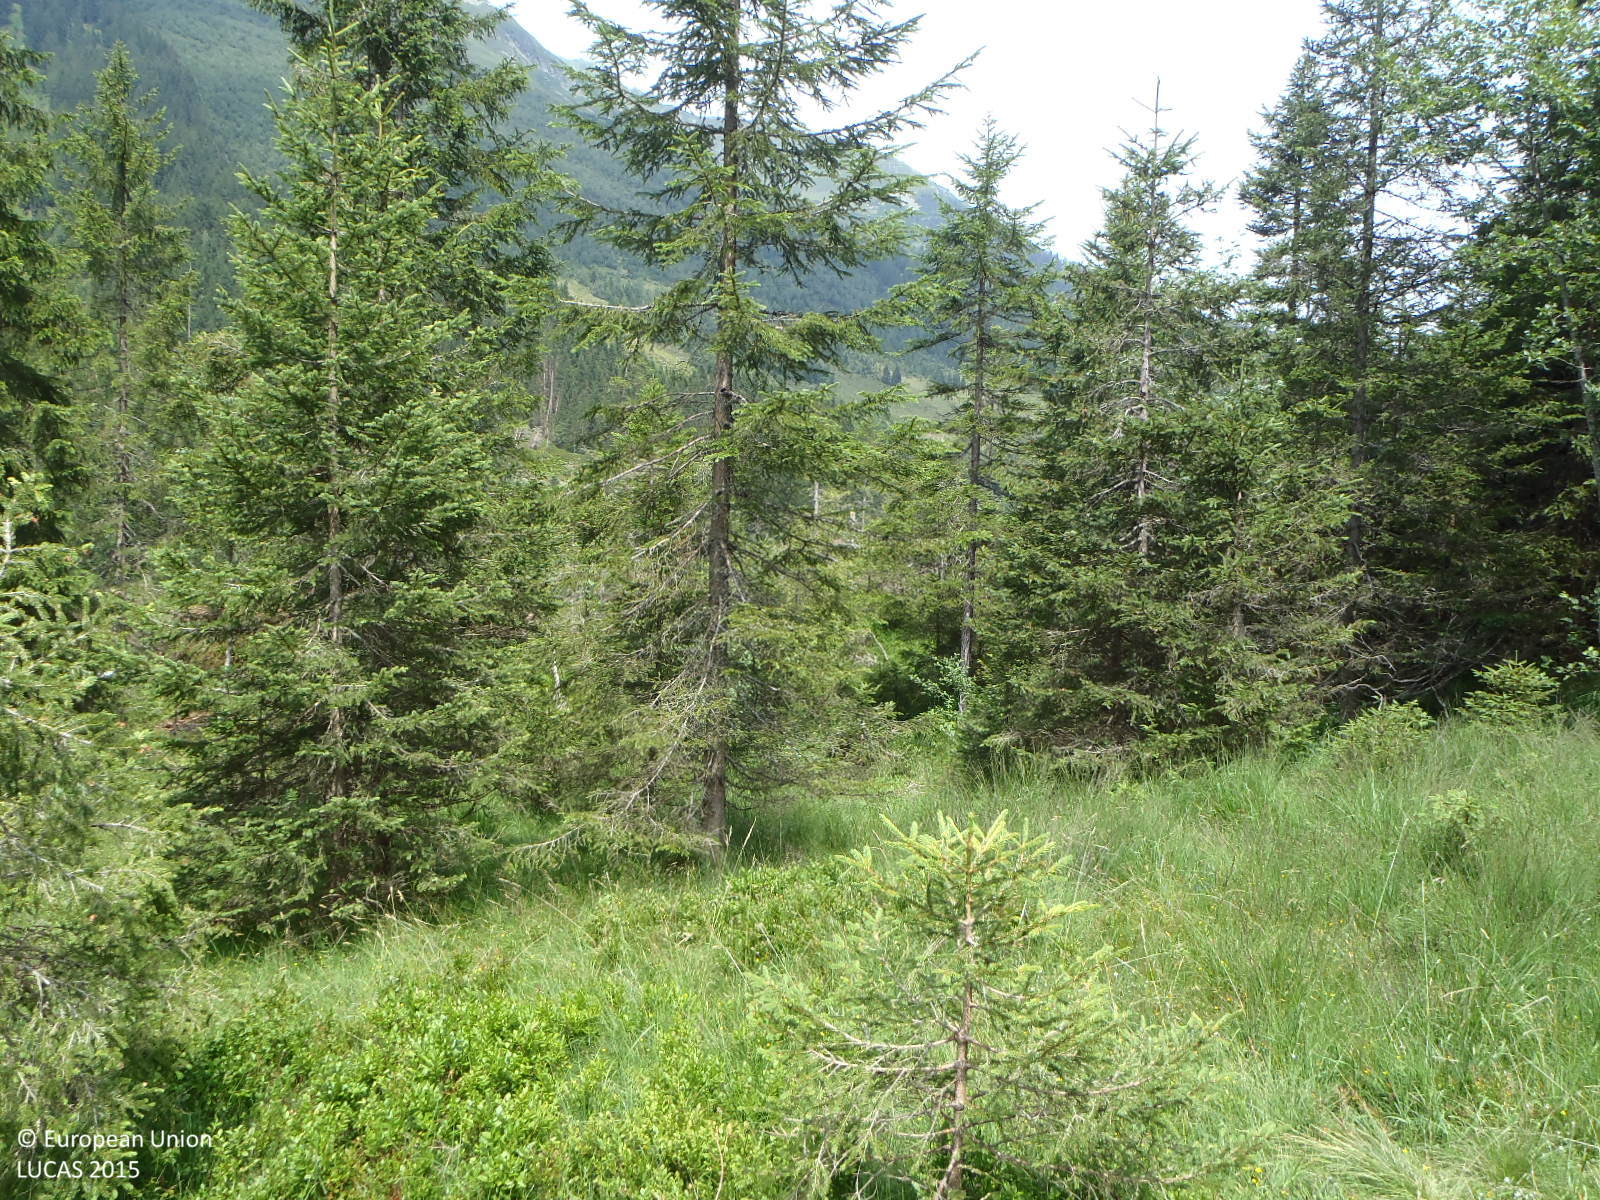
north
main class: Woodland
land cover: Spruce dominated mixed woodland
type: alpine coniferous forest
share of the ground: > 75 %
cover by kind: coniferous forest trees 50 %, broadleaved forest trees 25 %, herbaceous plants 25 %
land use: Forestry
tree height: > 5 m
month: July
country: AT
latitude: 47.2910
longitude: 11.7836
